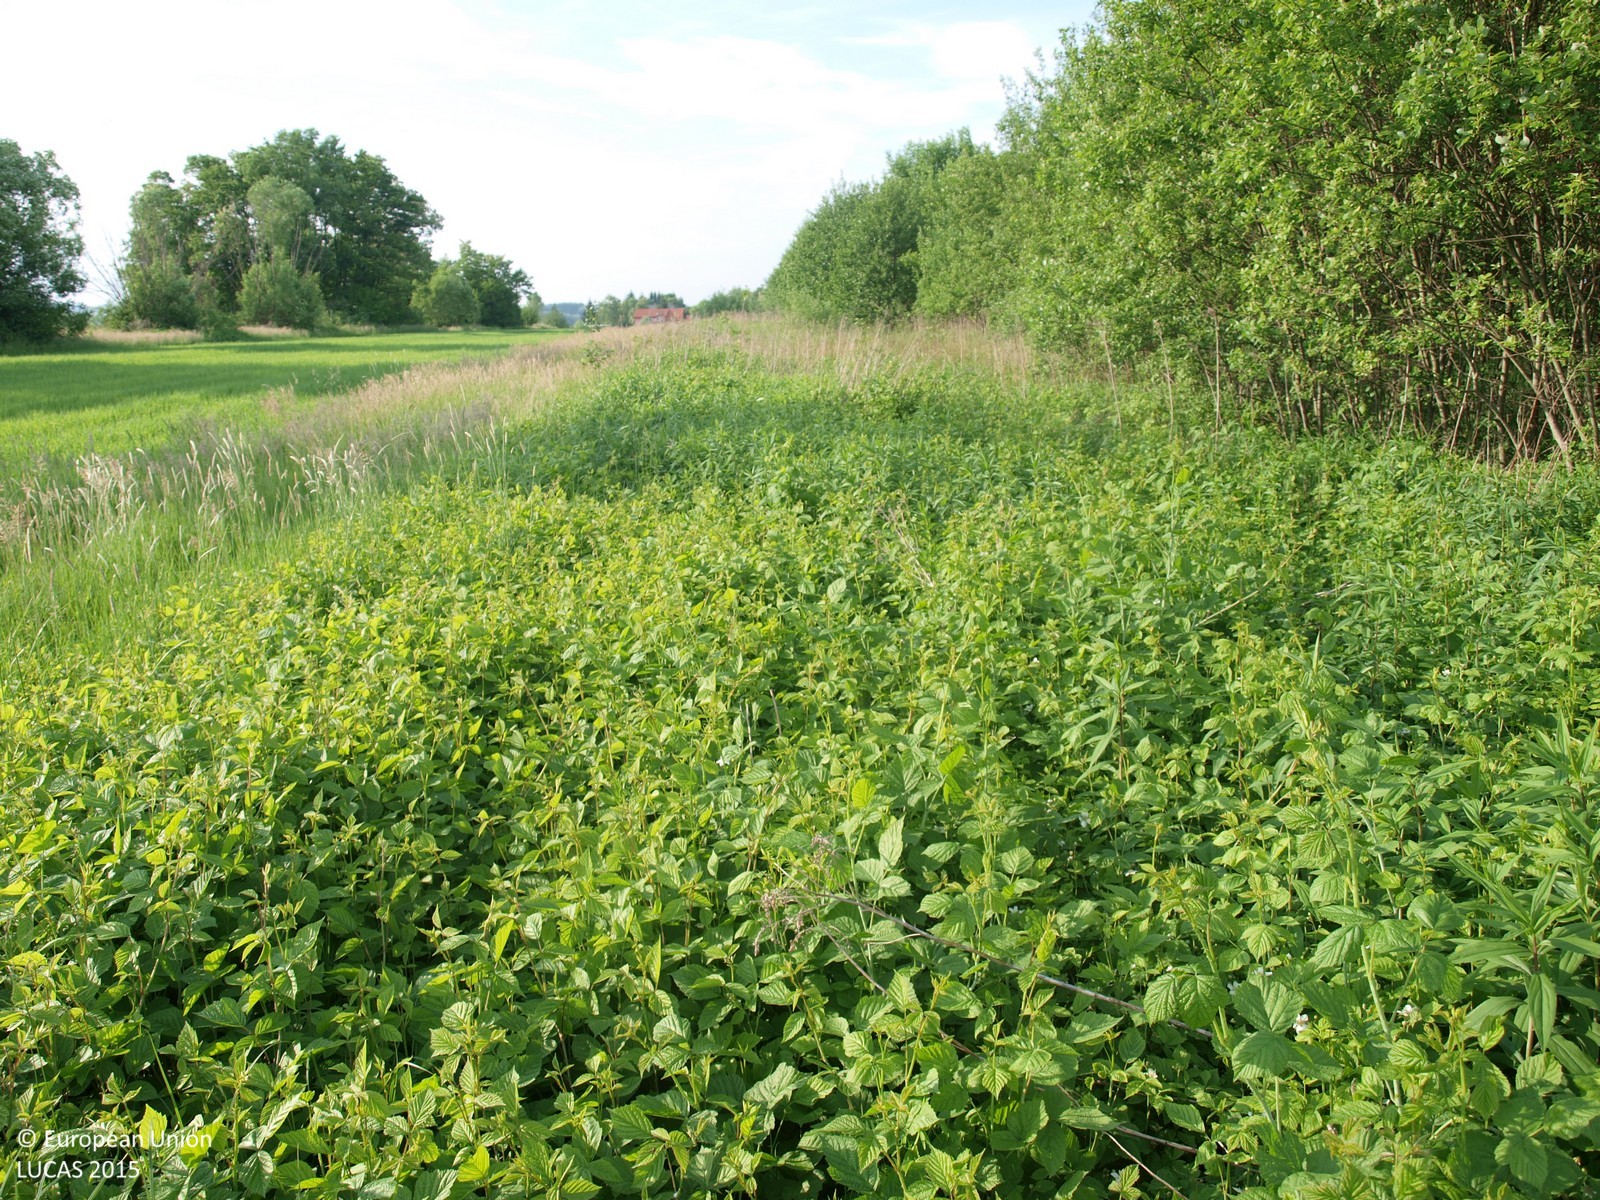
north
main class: Grassland
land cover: Spontaneously vegetated surfaces
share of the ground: > 75 %
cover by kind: herbaceous plants 95 %, shrubs 5 %
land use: Semi-natural and natural areas not in use
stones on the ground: < 10 %
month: May
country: HR
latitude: 46.2474
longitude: 16.1344
